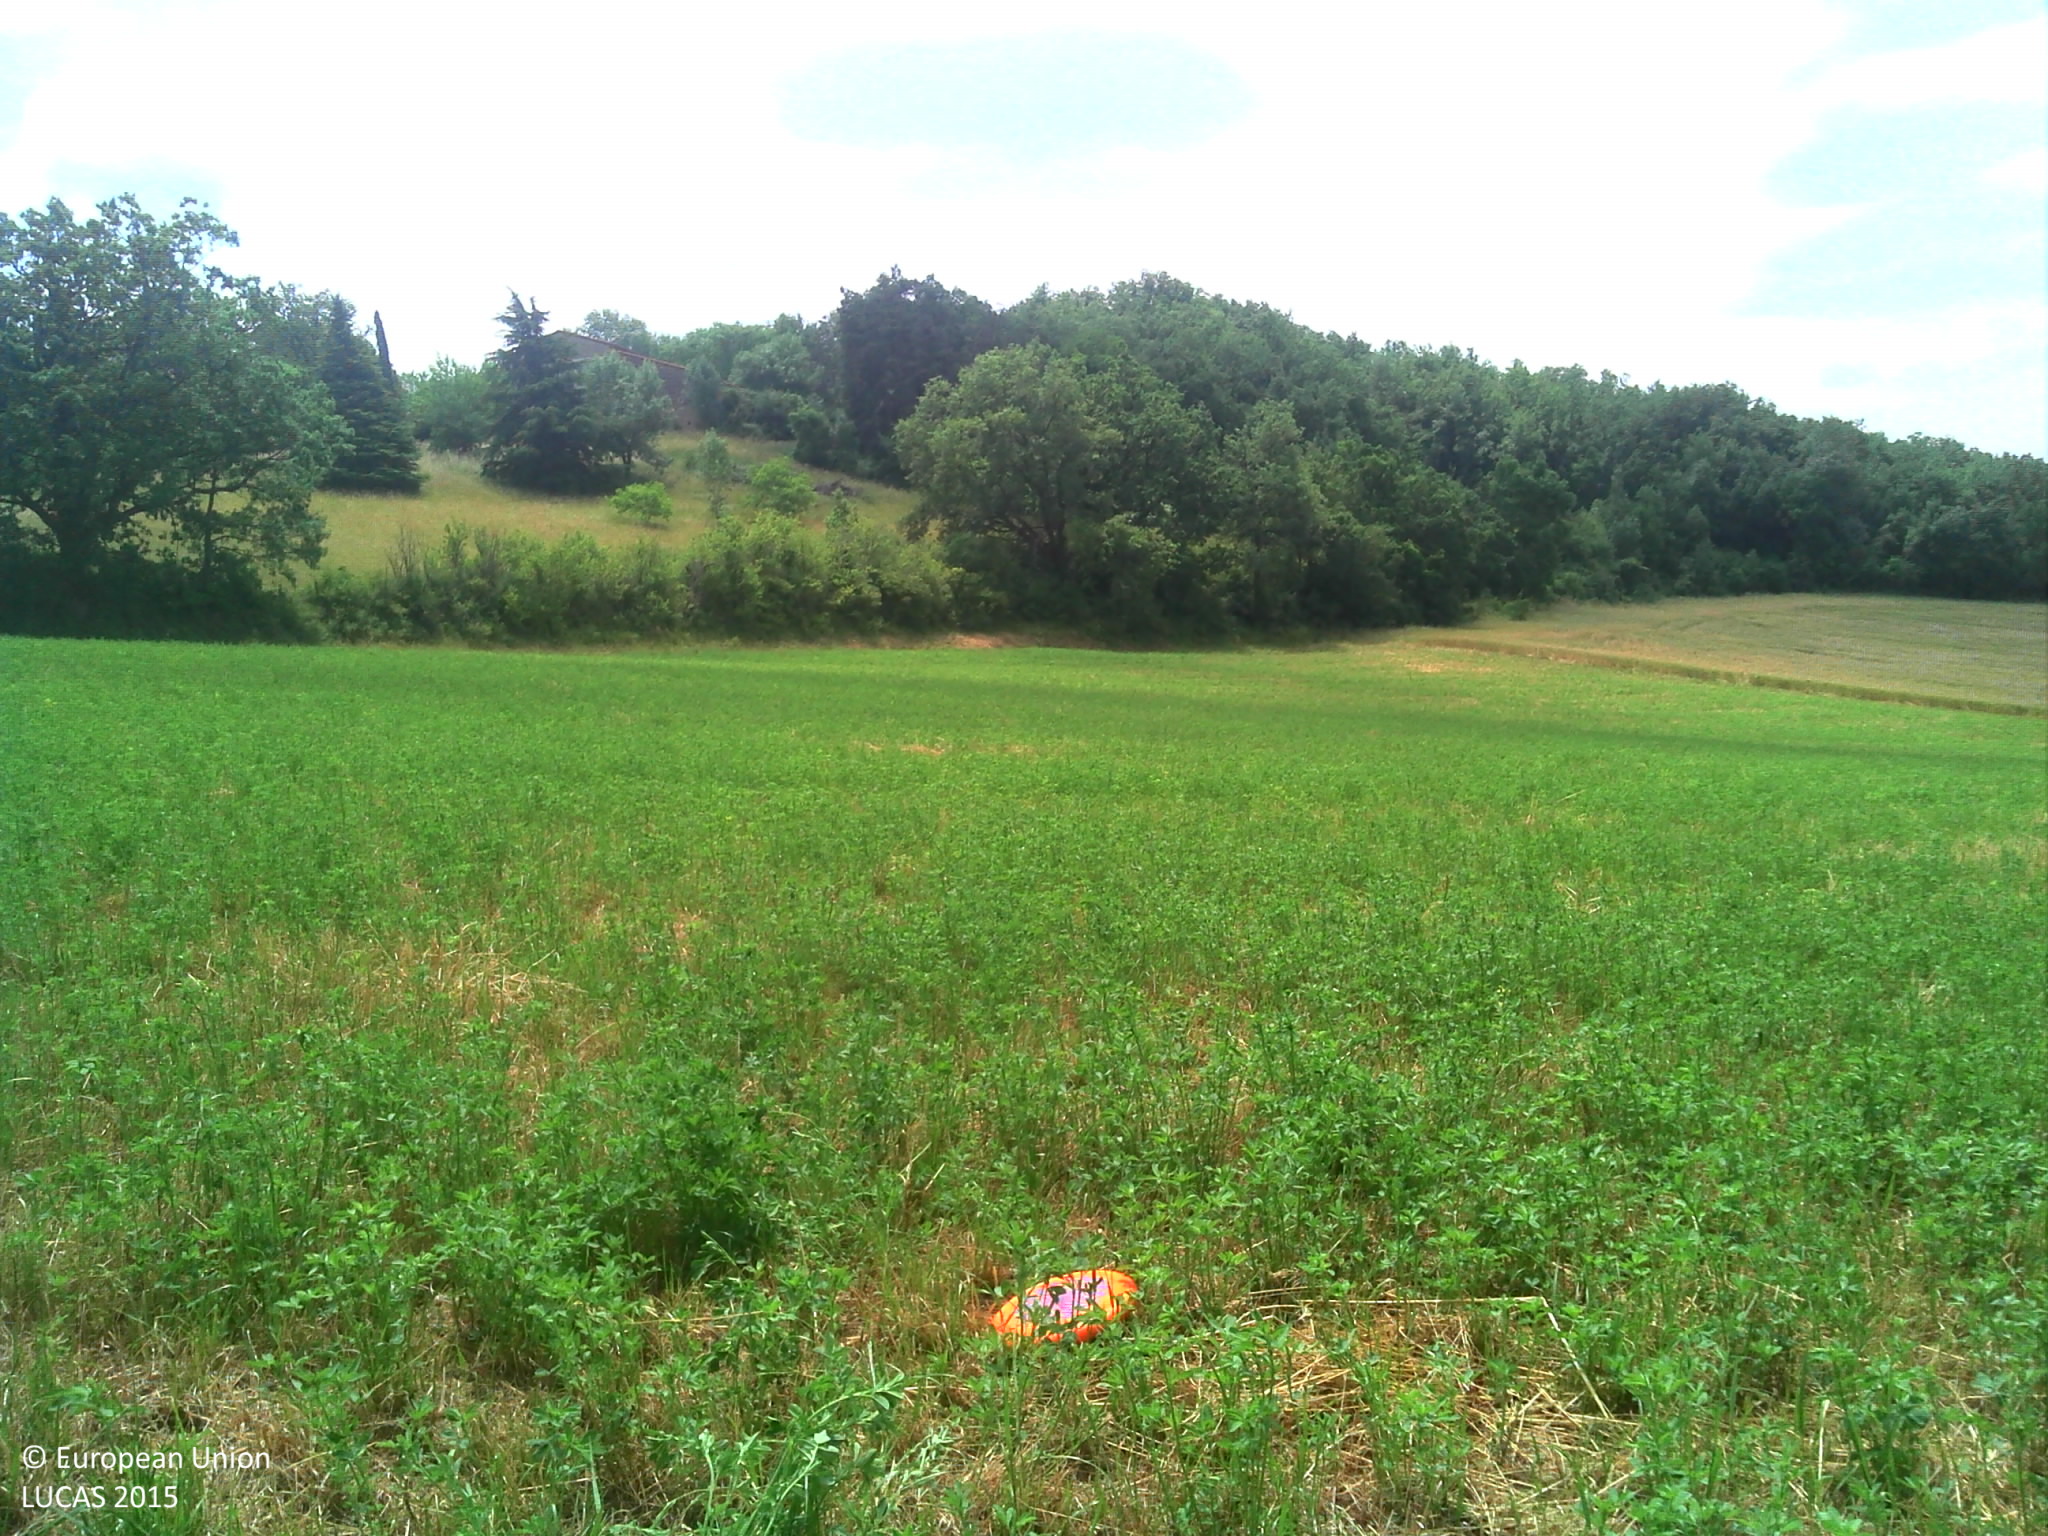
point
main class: Cropland
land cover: Lucerne
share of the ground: > 75 %
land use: Agriculture (excluding fallow land and kitchen gardens)
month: June
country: FR
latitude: 43.7605
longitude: 2.1172
